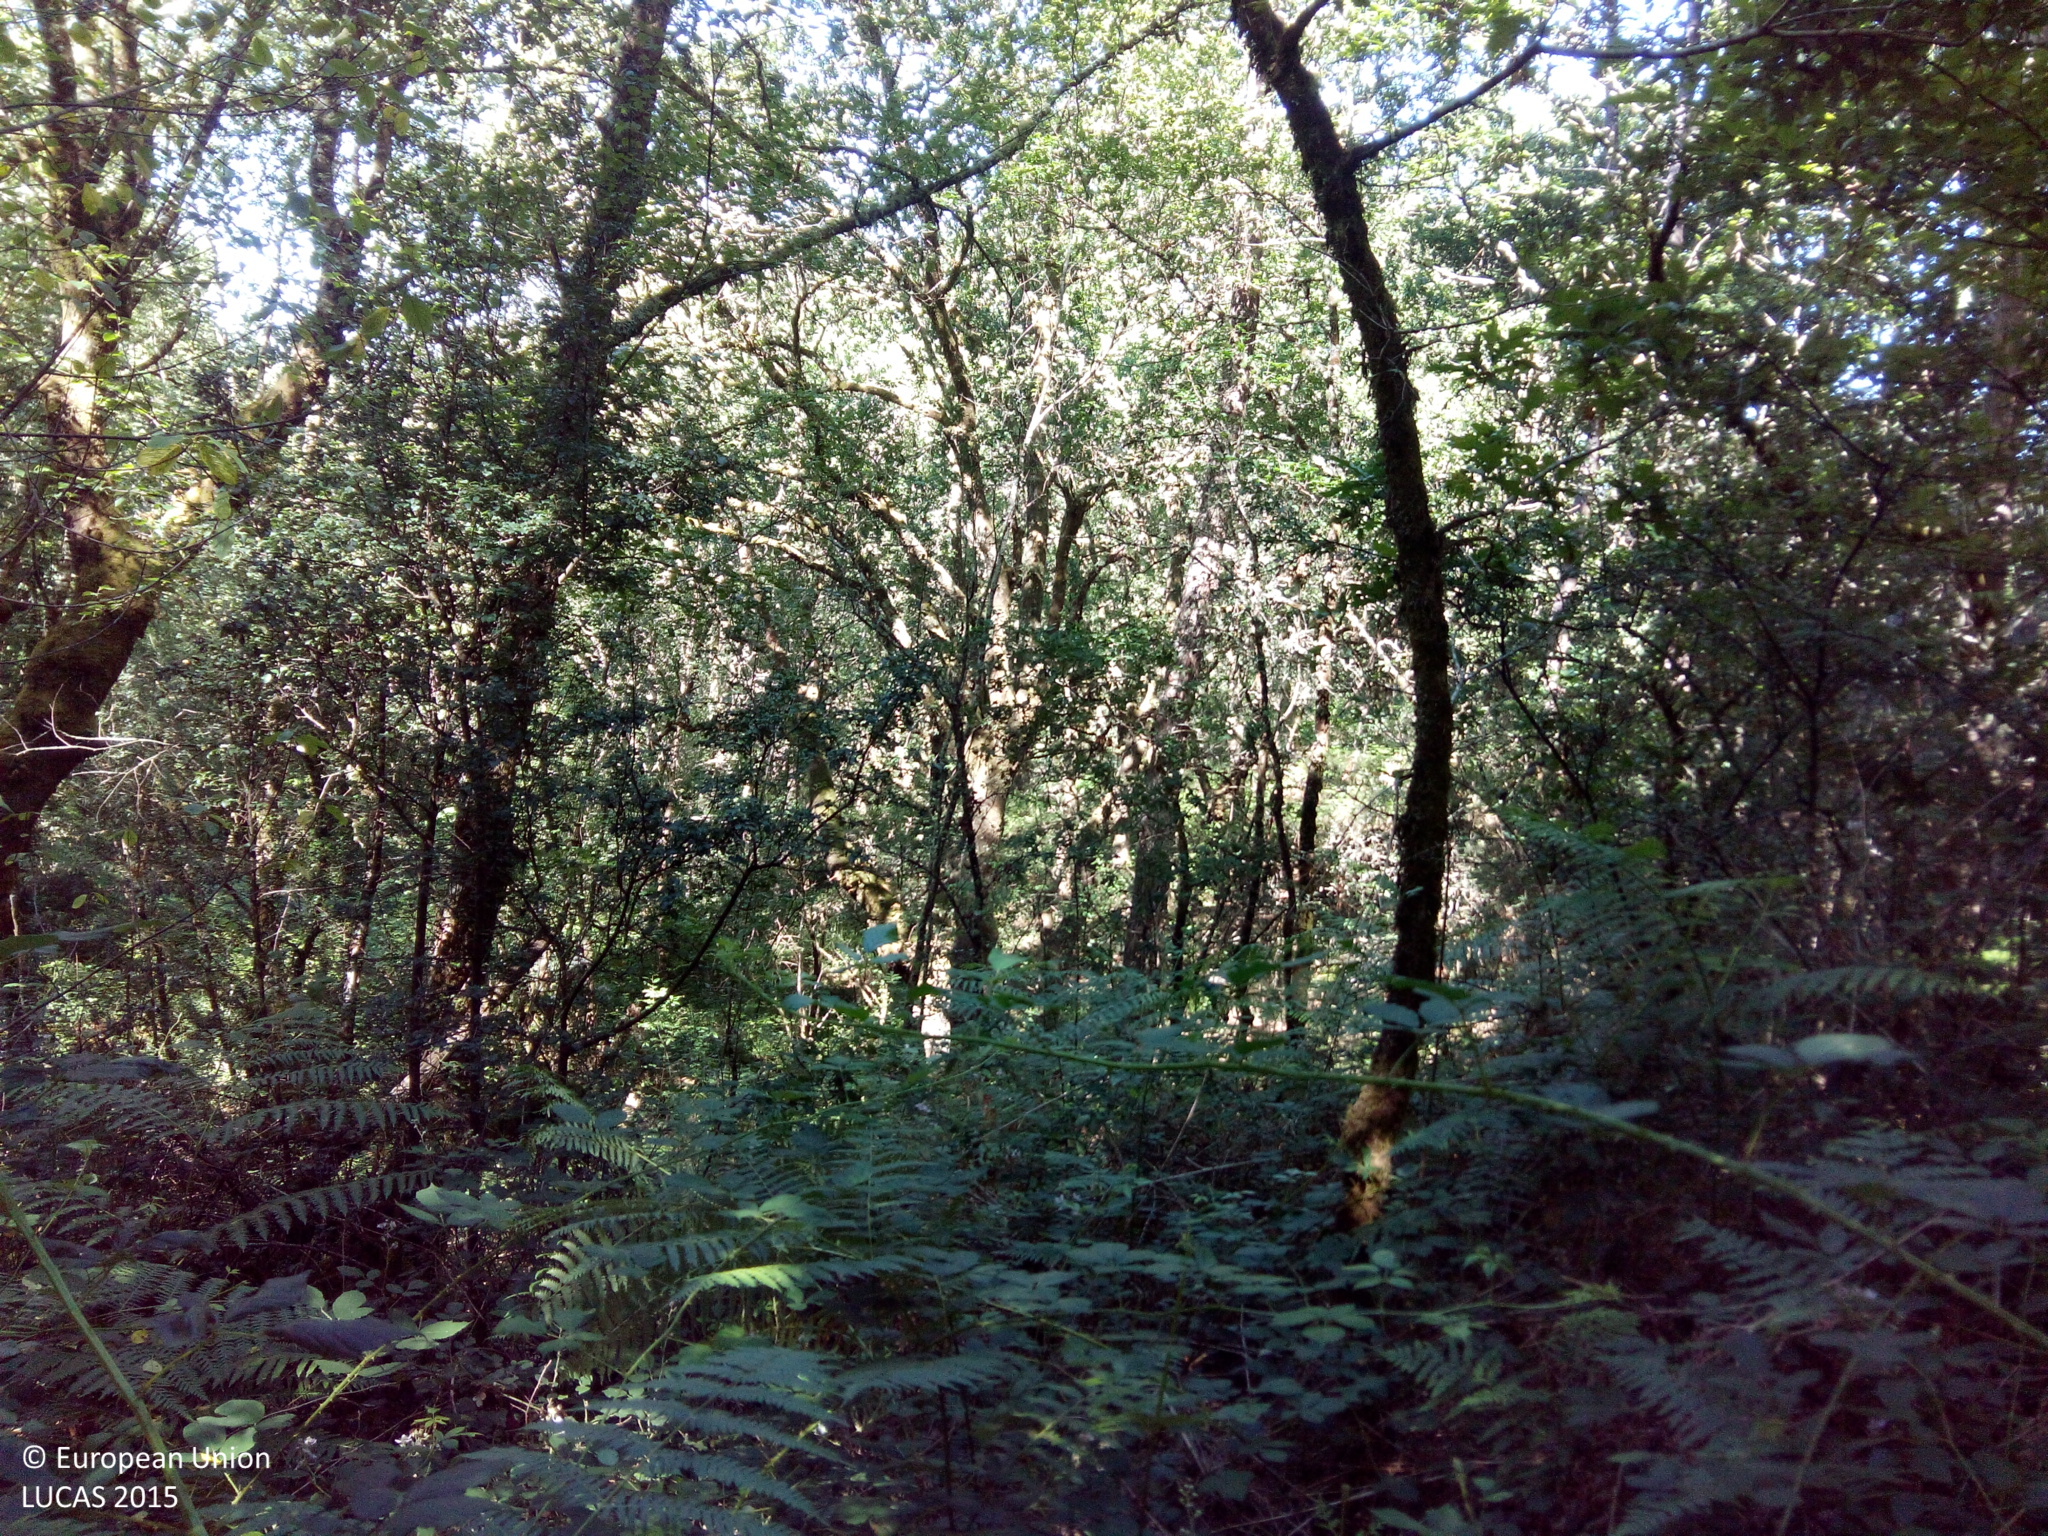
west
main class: Woodland
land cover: Broadleaved woodland
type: acidophilous oak and oak-birch forest
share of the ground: > 75 %
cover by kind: broadleaved forest trees 100 %
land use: Forestry
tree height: > 5 m
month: June
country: ES
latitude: 42.5492
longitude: -8.3492
